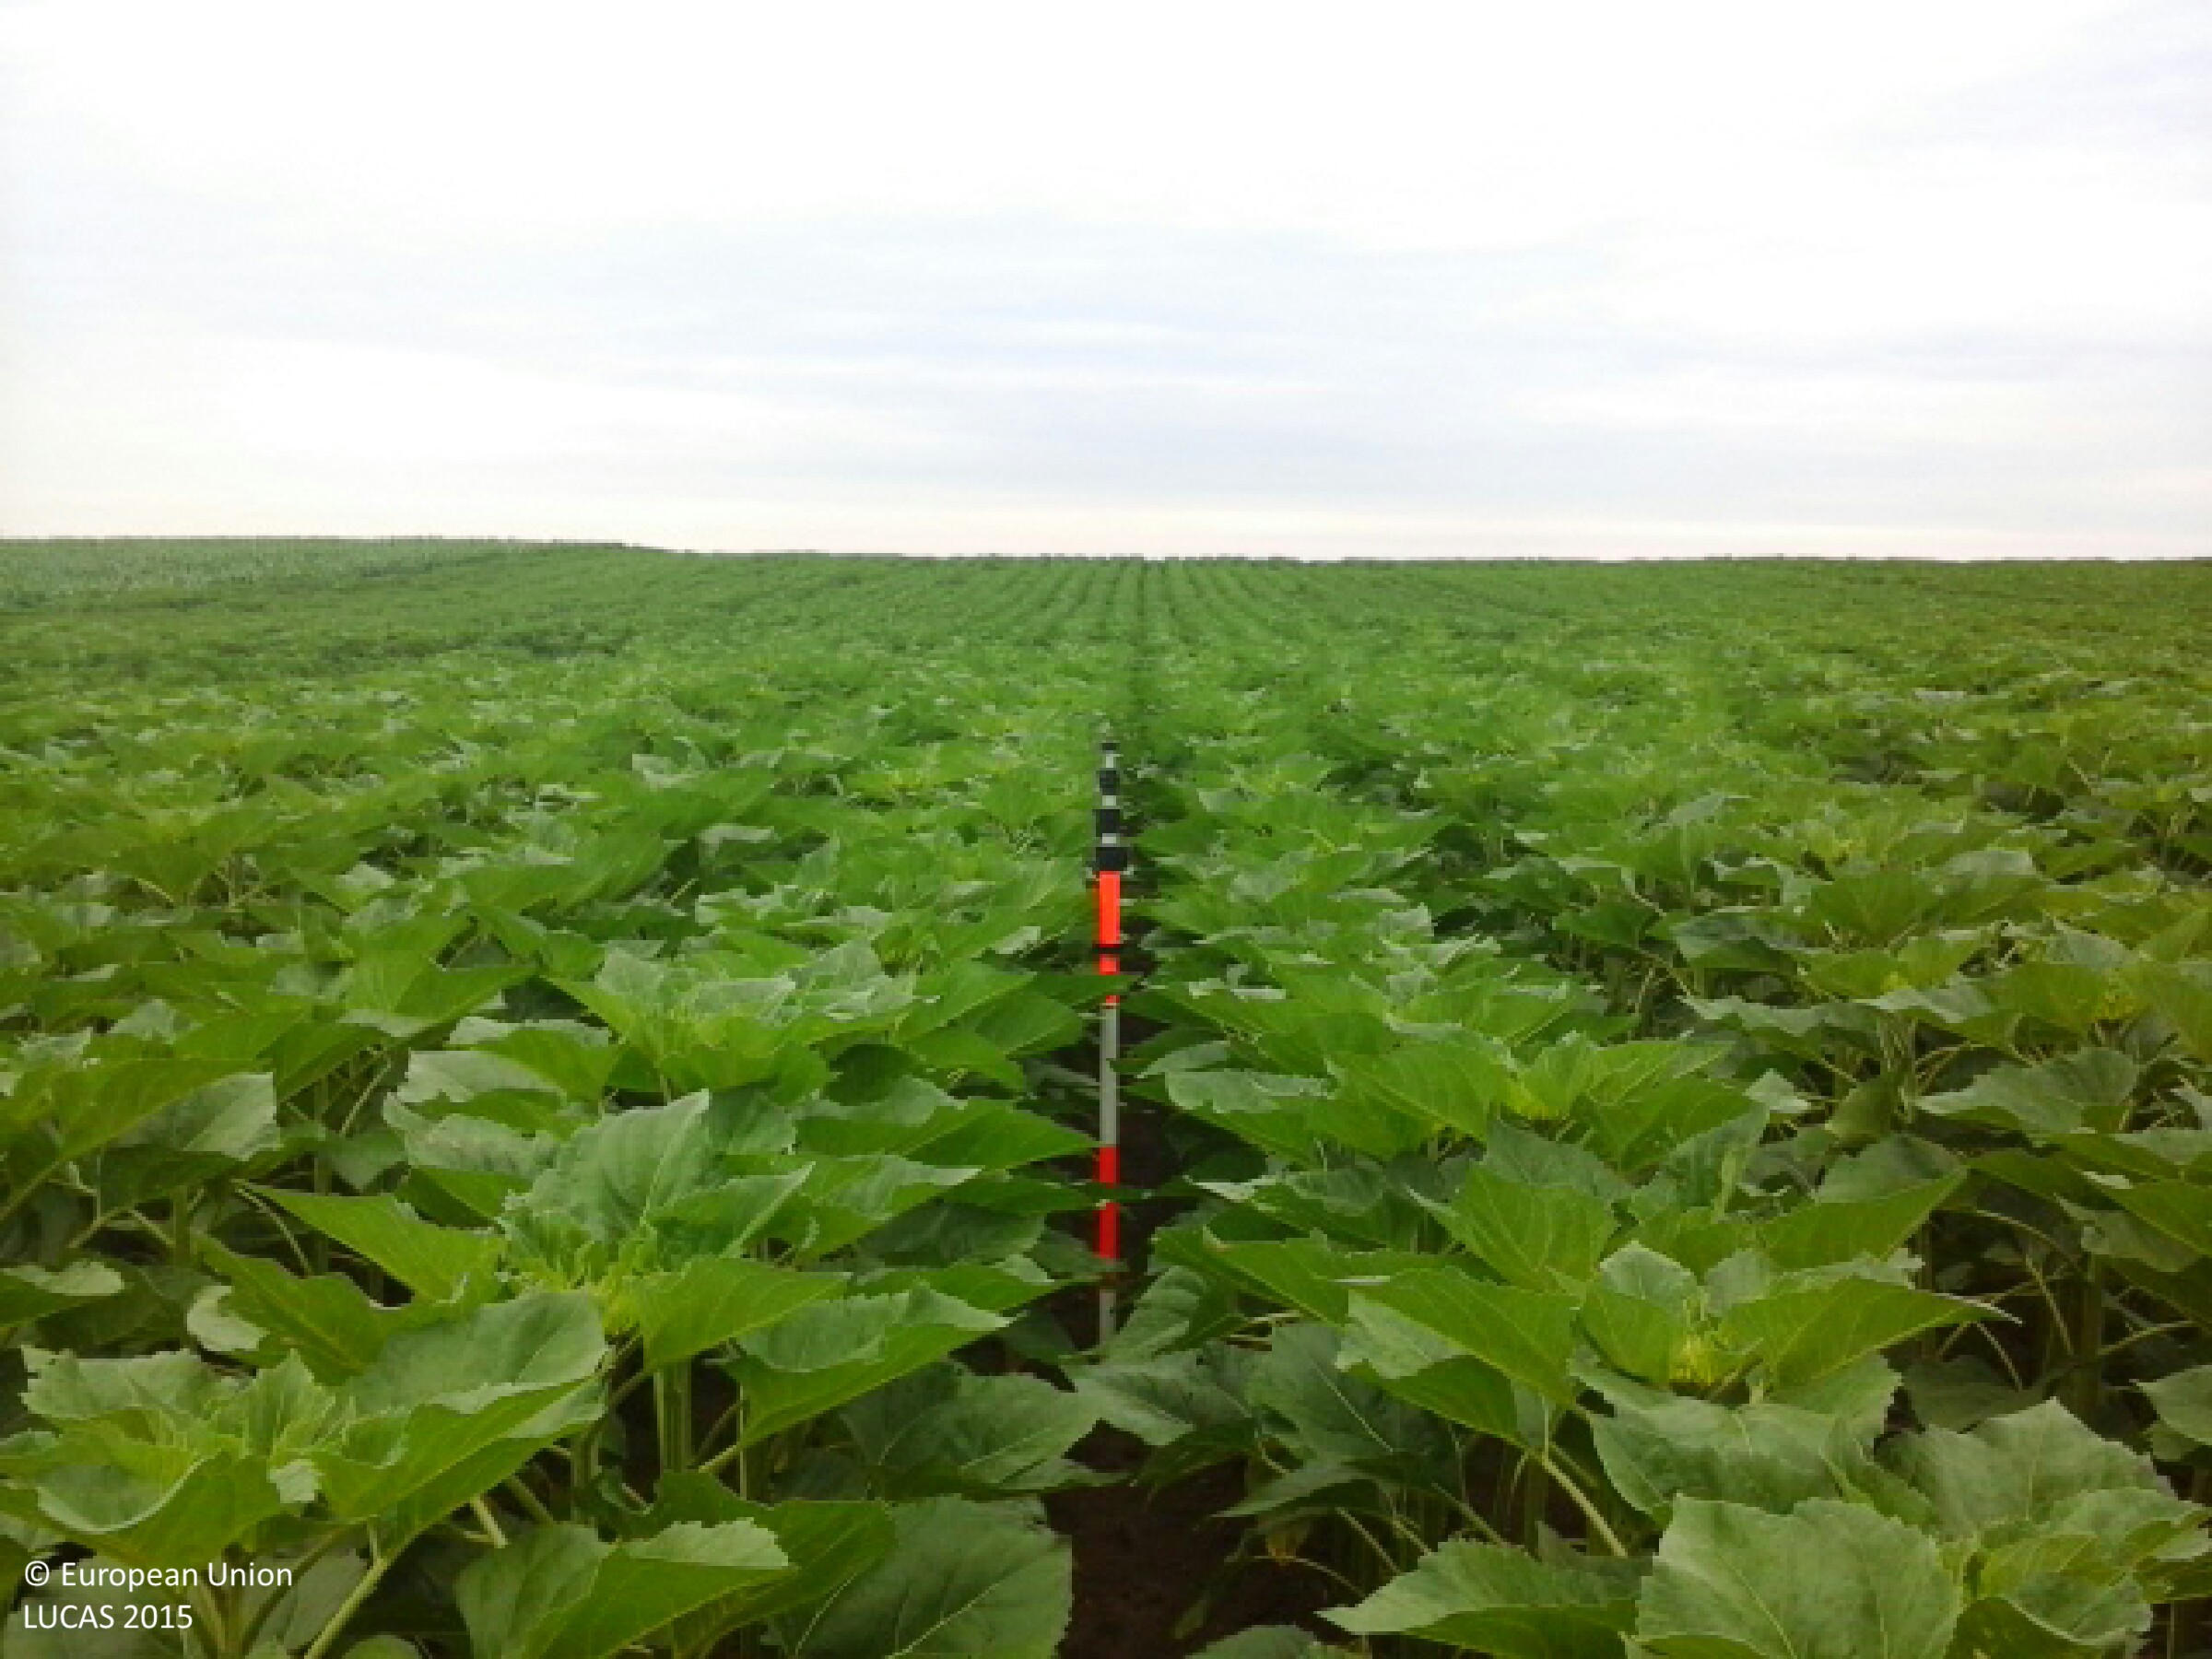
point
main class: Cropland
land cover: Sunflower
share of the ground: > 75 %
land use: Agriculture (excluding fallow land and kitchen gardens)
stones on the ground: < 10 %
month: June
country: HU
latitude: 48.1398
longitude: 21.5637
